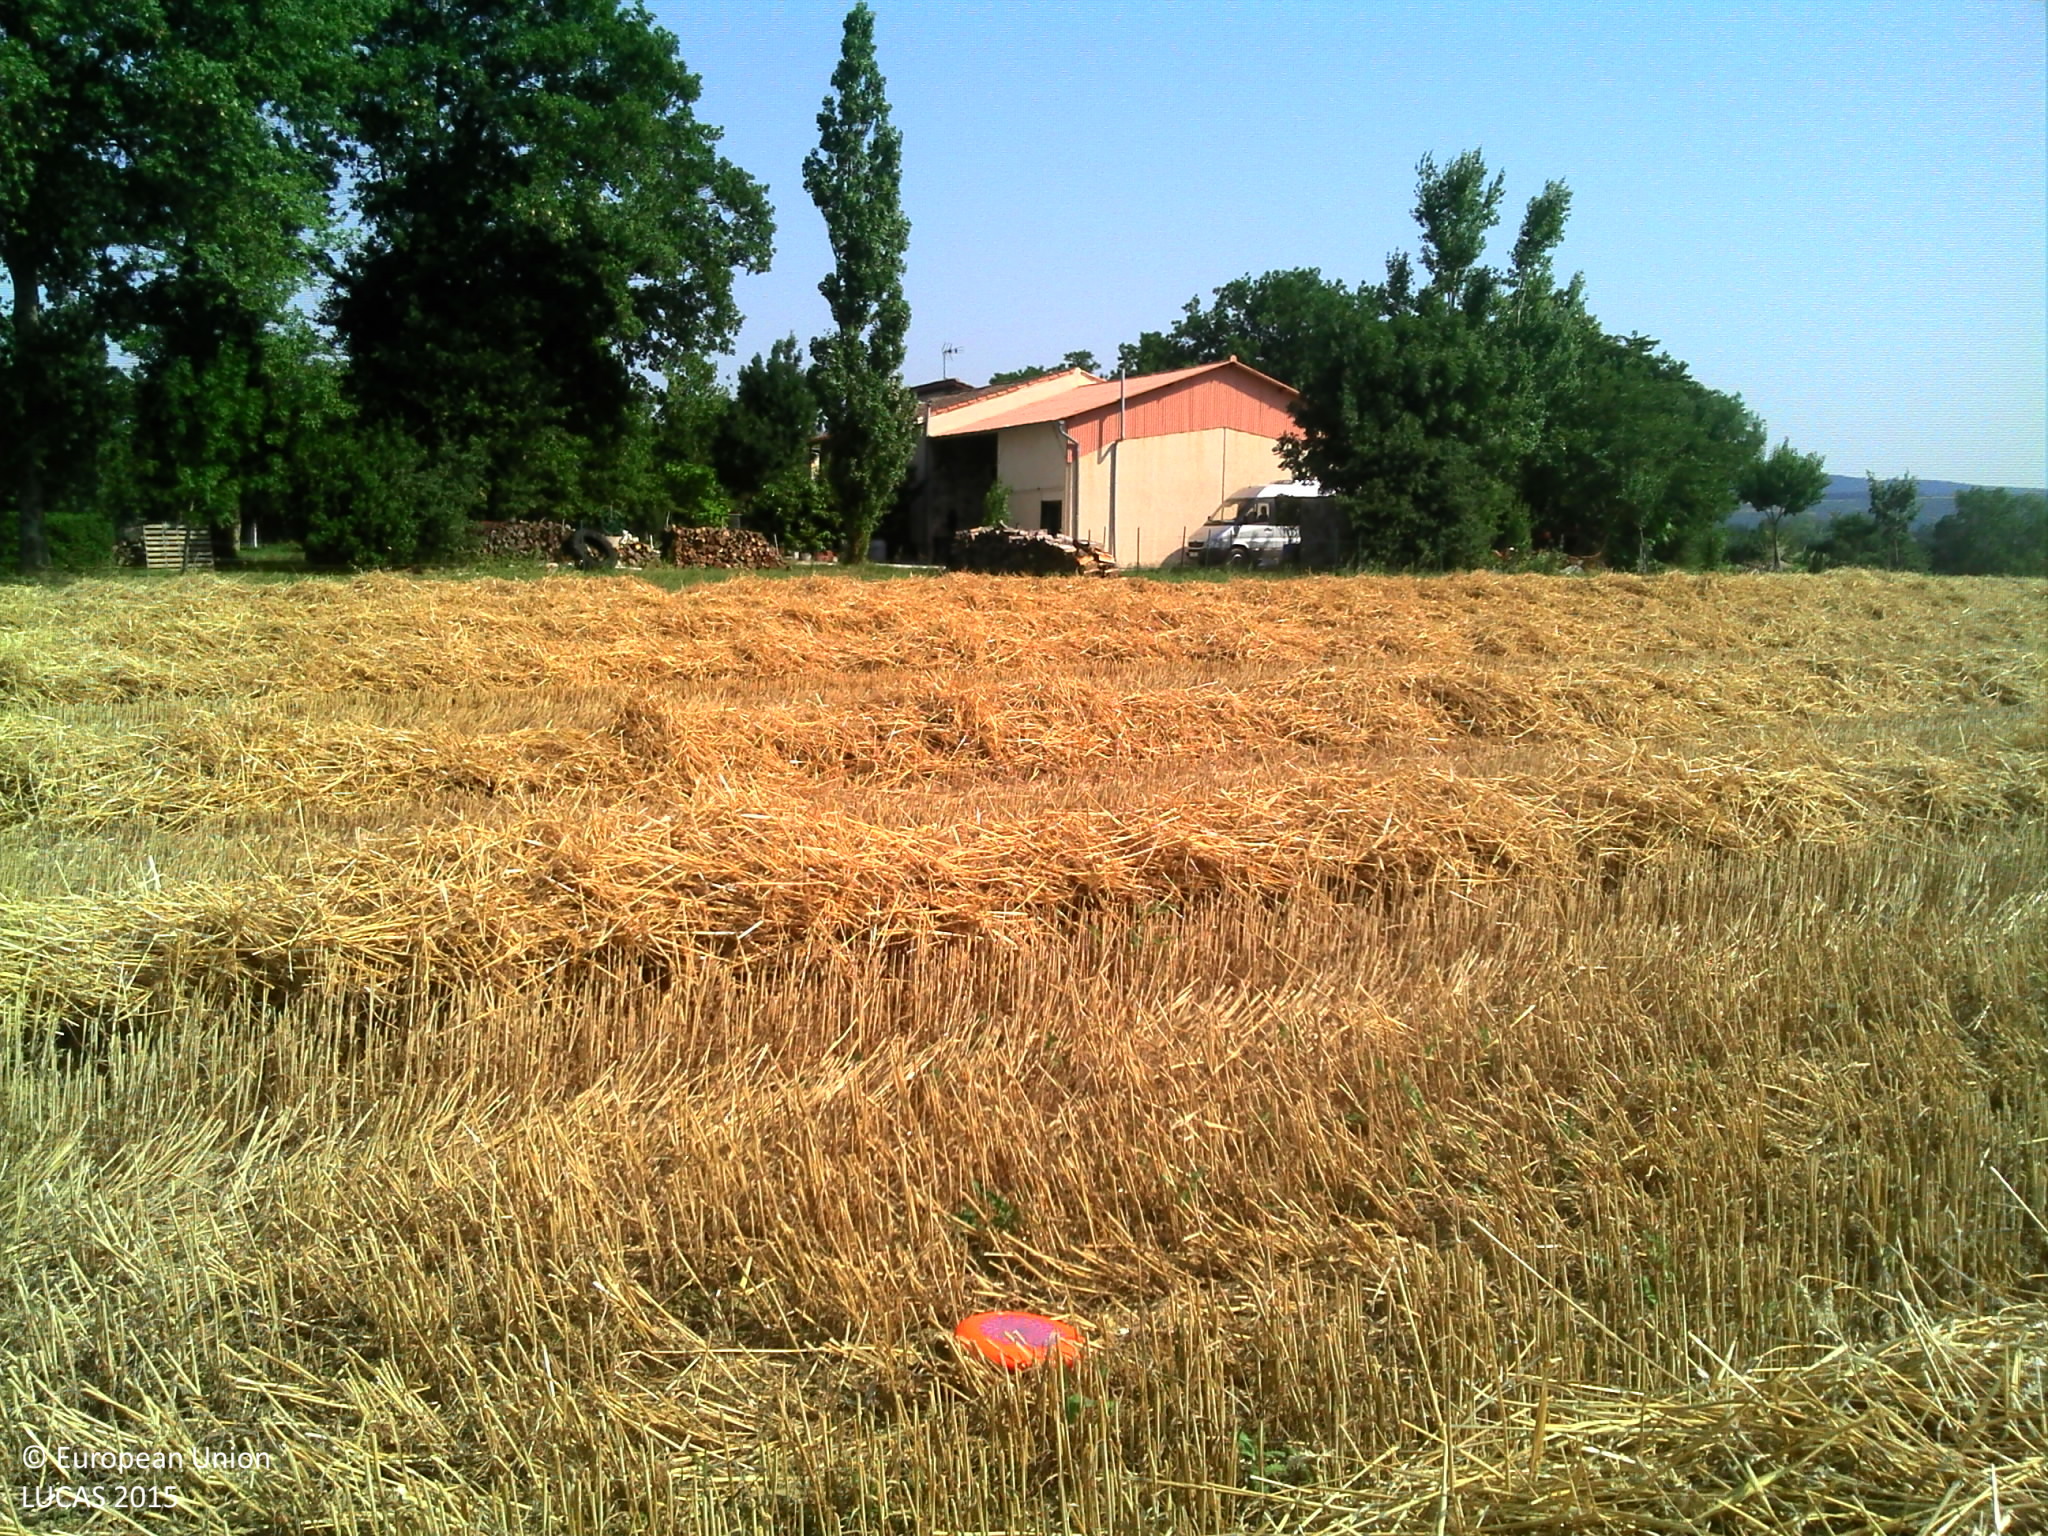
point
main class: Cropland
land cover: Common wheat
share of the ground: > 75 %
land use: Agriculture (excluding fallow land and kitchen gardens)
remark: Harvested field
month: July
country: FR
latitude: 43.4801
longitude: 2.0064
